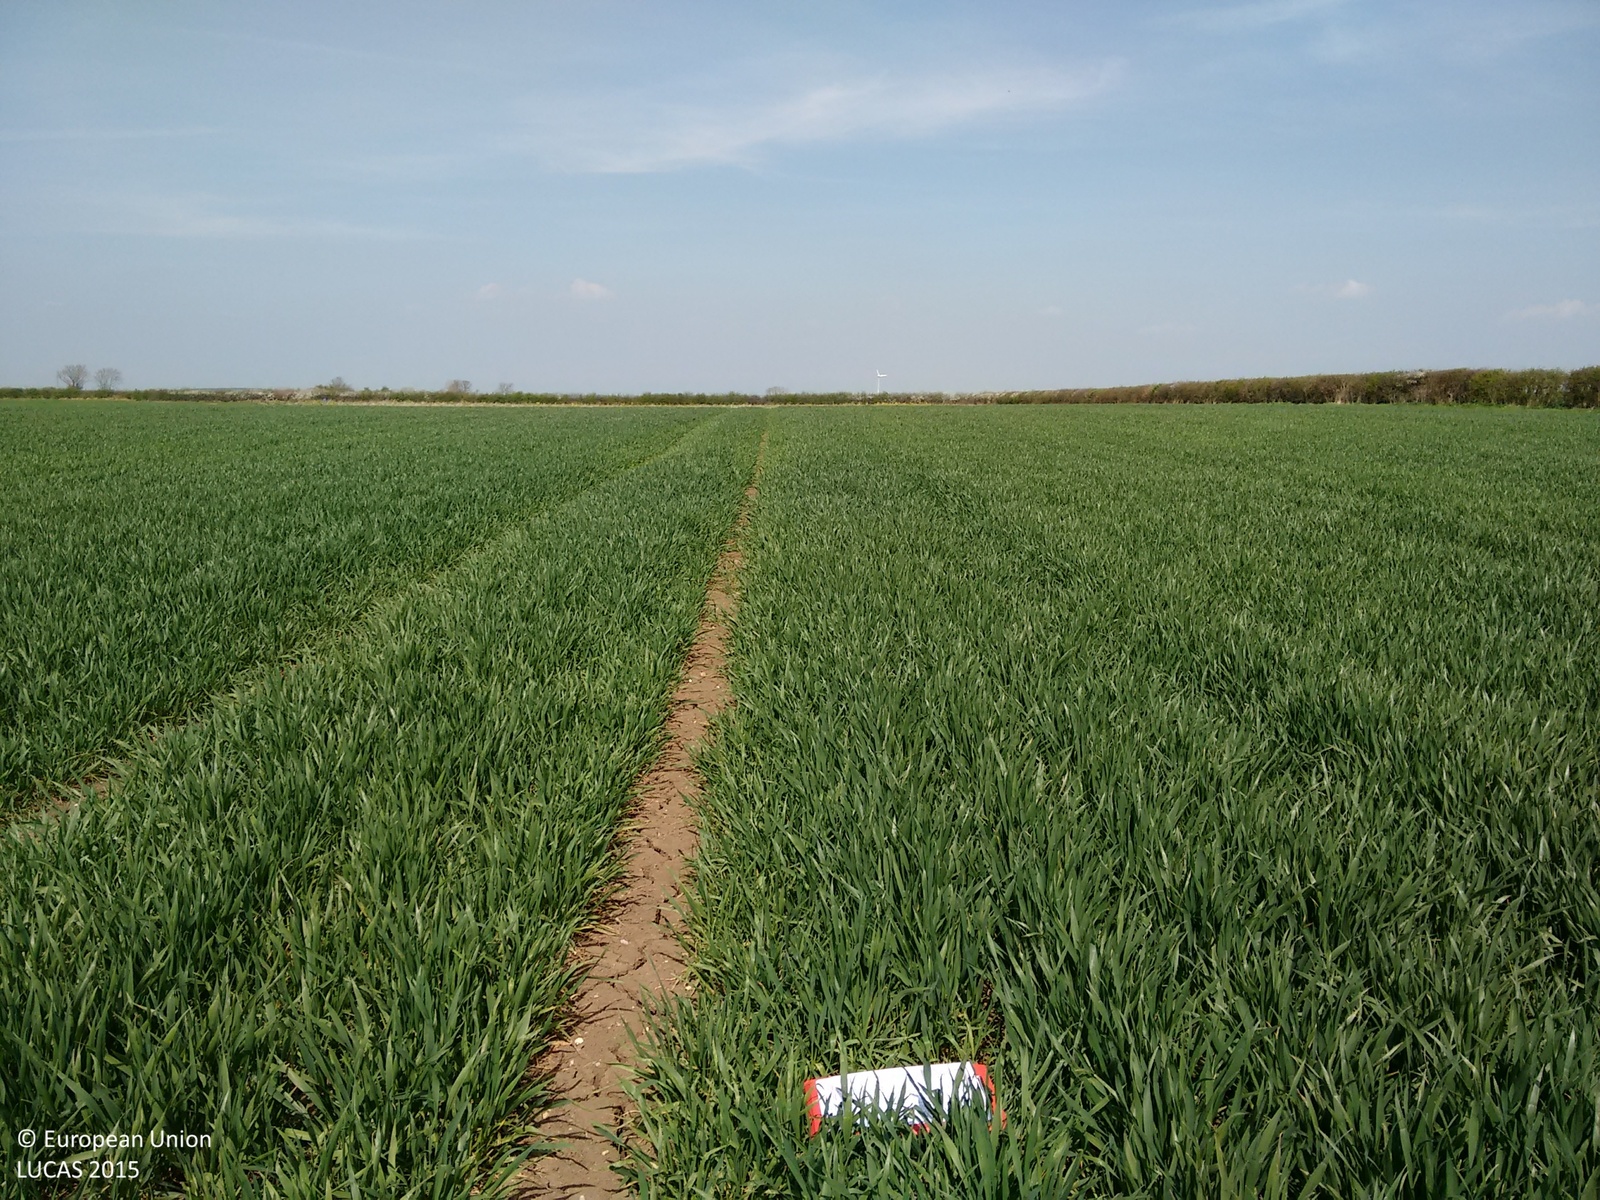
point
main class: Cropland
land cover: Barley
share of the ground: > 75 %
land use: Agriculture (excluding fallow land and kitchen gardens)
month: April
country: GB
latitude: 53.4360
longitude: -0.6818
